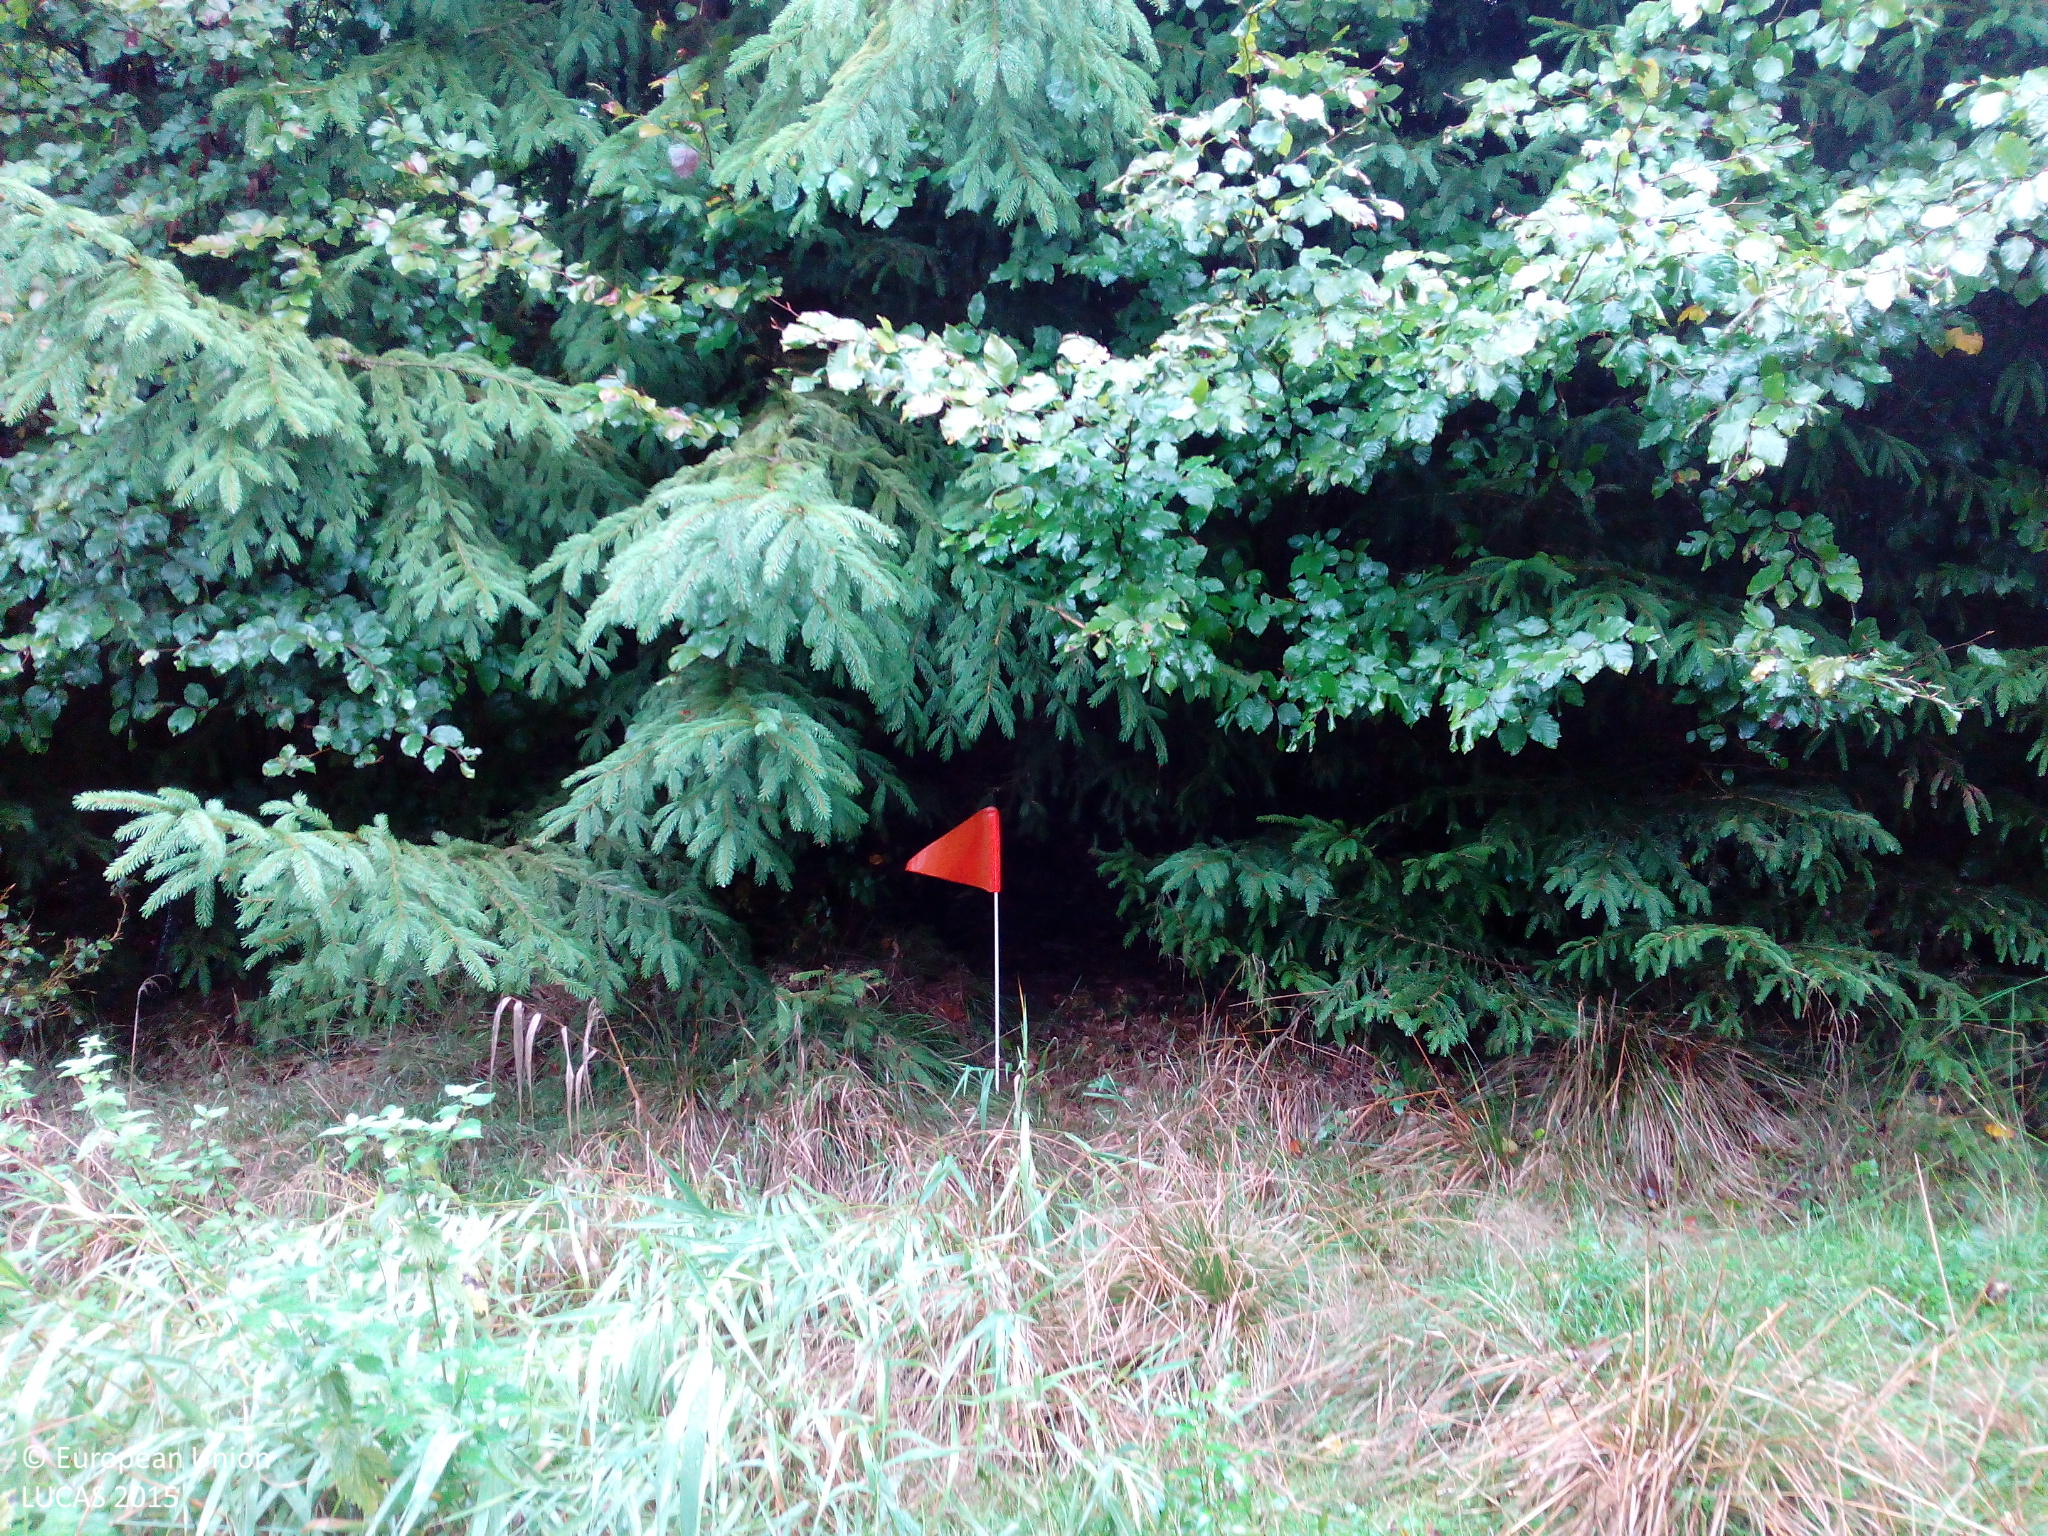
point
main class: Woodland
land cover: Spruce dominated mixed woodland
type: hemiboreal forest and nemoral coniferous forest and mixed broadleaved-coniferous forest
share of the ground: > 75 %
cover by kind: coniferous forest trees 60 %, broadleaved forest trees 40 %
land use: Forestry
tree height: < 5 m
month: September
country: DE
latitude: 49.9318
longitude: 9.5961
